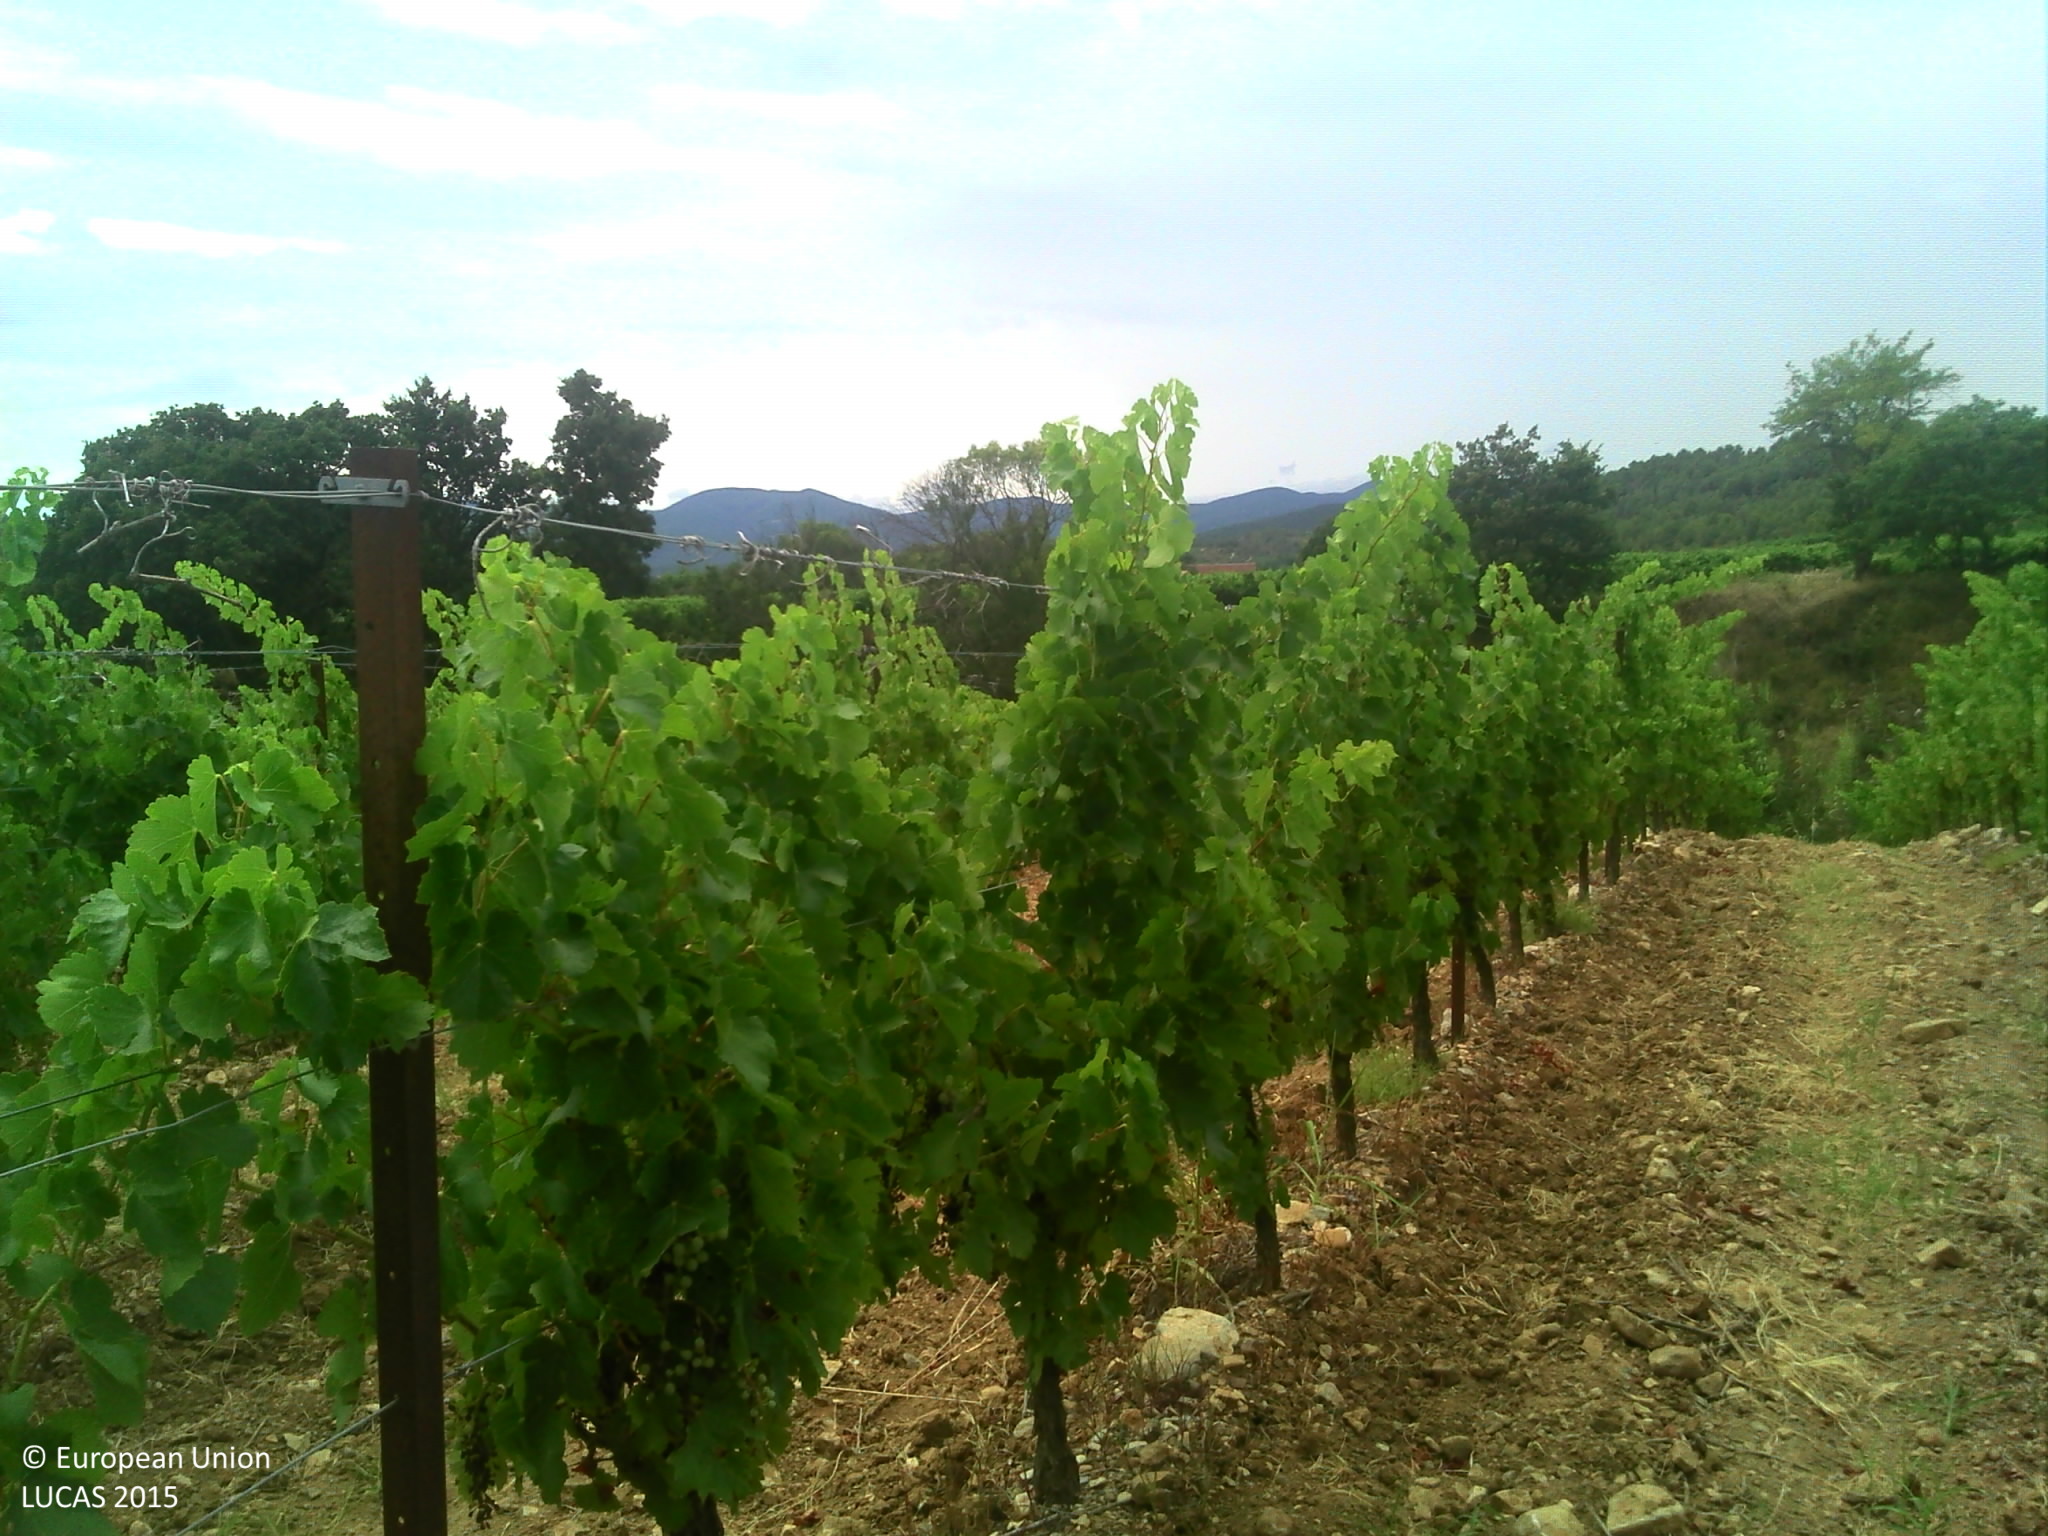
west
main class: Cropland
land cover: Vineyards
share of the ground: 25 - 50 %
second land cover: Other bare soil
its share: > 75 %
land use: Agriculture (excluding fallow land and kitchen gardens)
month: July
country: FR
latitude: 43.4494
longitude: 3.0763
